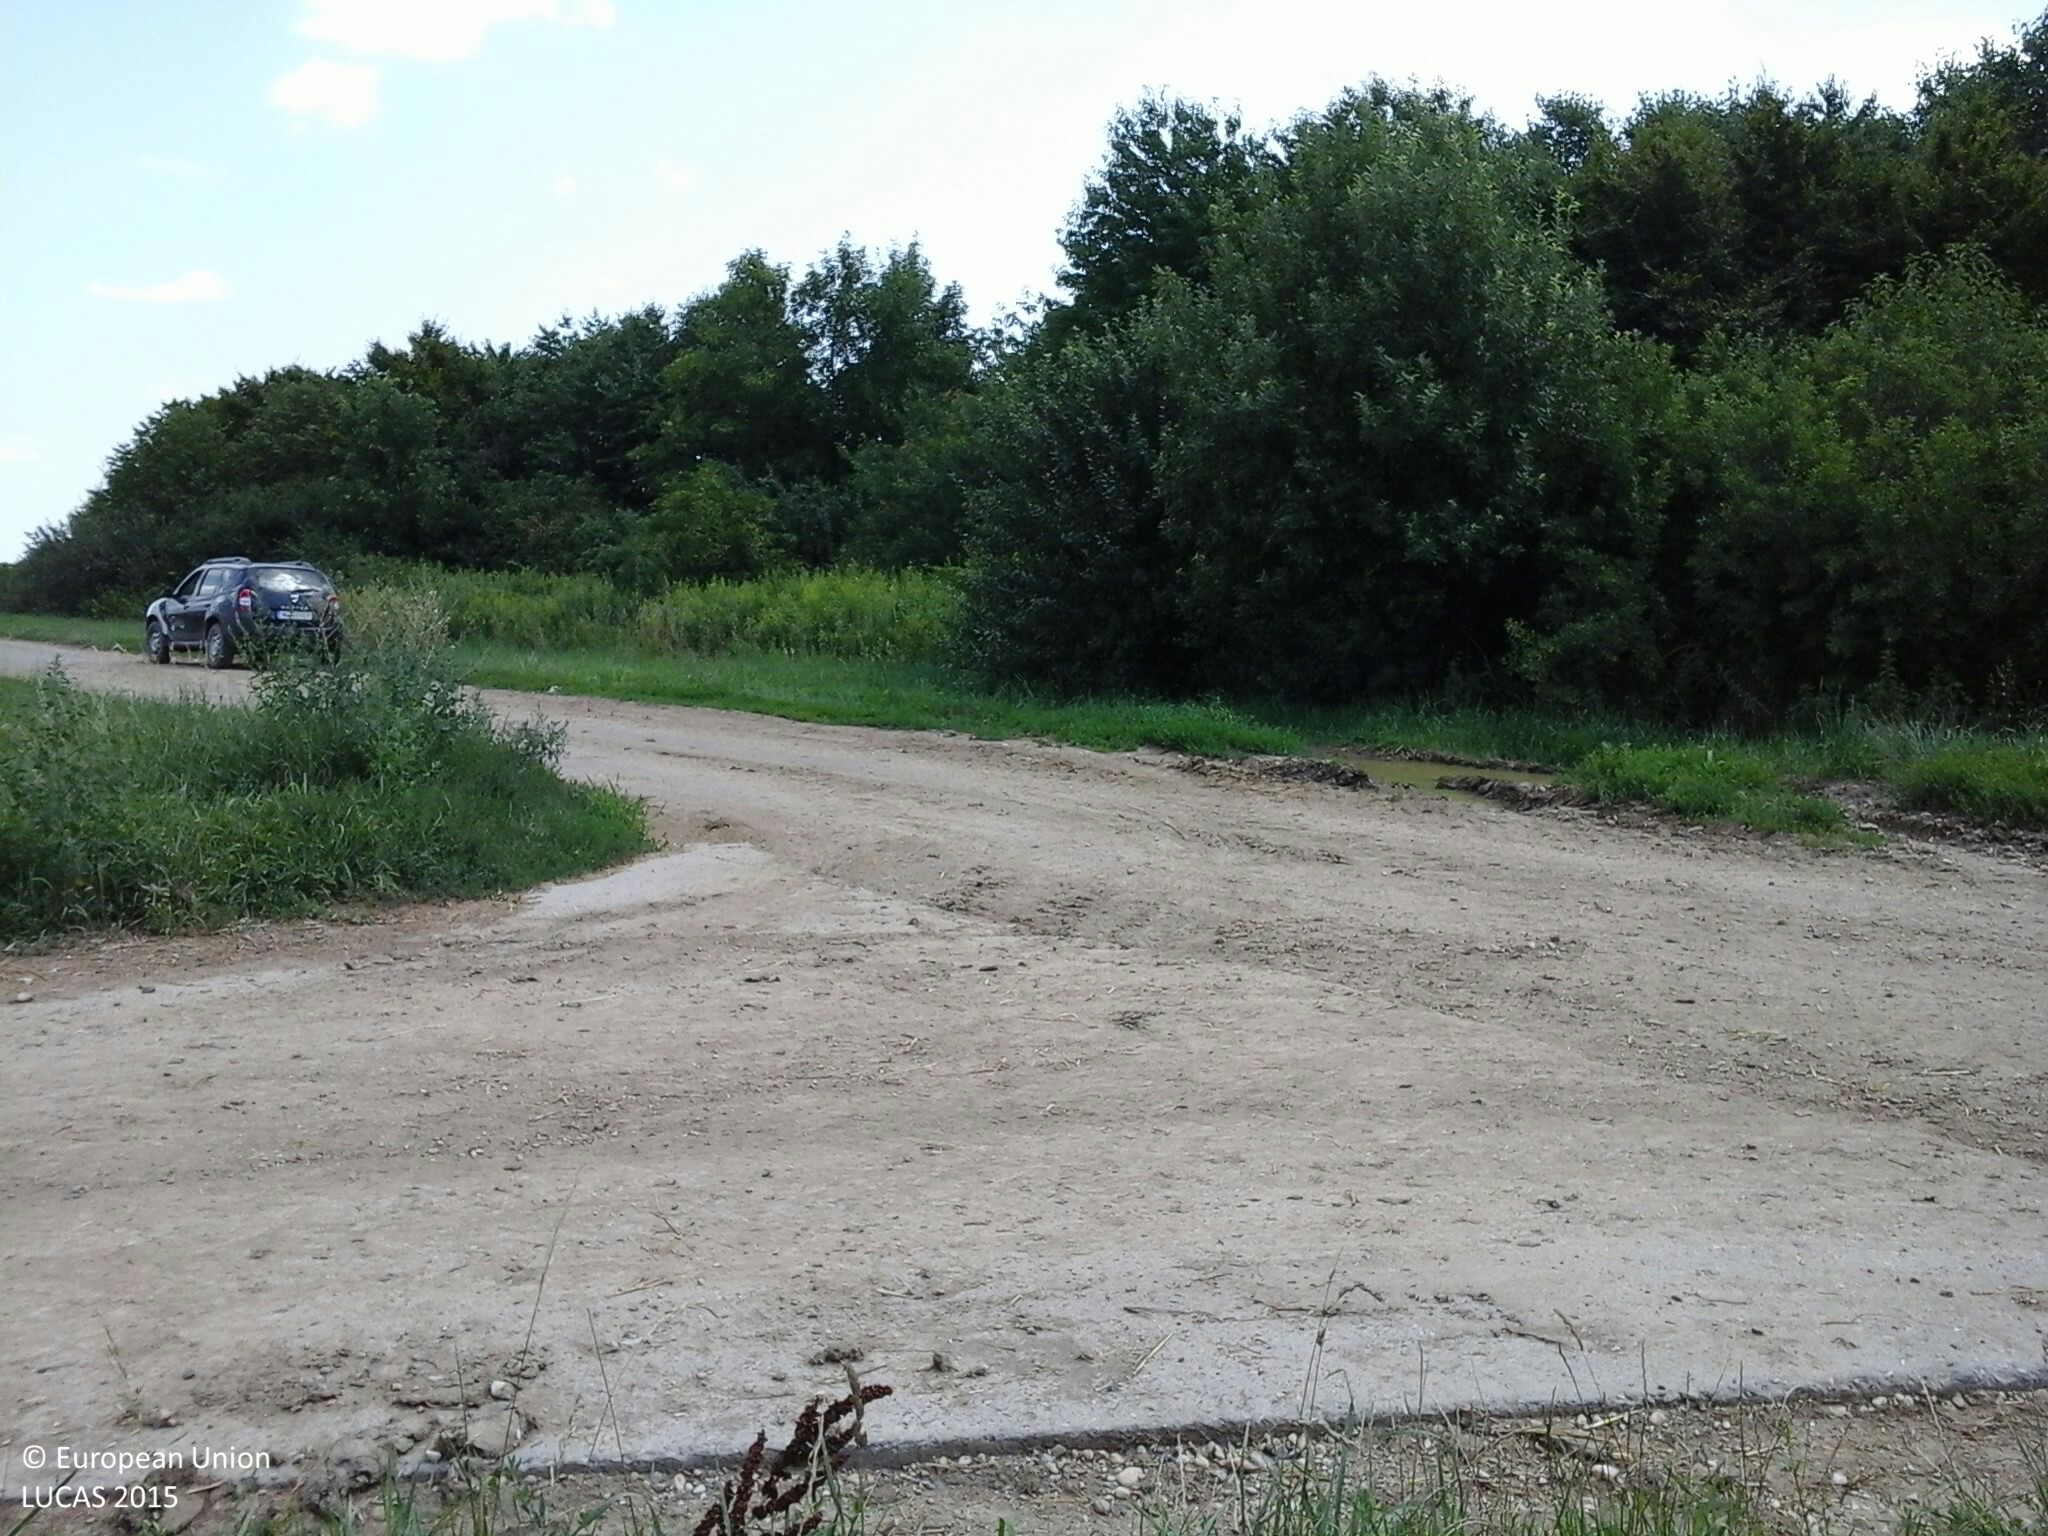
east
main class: Grassland
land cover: Grassland without tree/shrub cover
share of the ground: > 75 %
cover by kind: herbaceous plants 95 %, shrubs 5 %
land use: Road transport
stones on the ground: < 10 %
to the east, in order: Grassland without tree/shrub cover; Ditches and canals; Grass margins; Paved roads, cycling and walking lanes; Grass margins; Ditches and canals; Broadleaved woodland; Durum wheat; Grass margins; Tracks; Shrubland with sparse tree cover; Ditches and canals; Shrubland with sparse tree cover; Maize
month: July
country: HU
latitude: 47.0196
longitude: 16.5148
